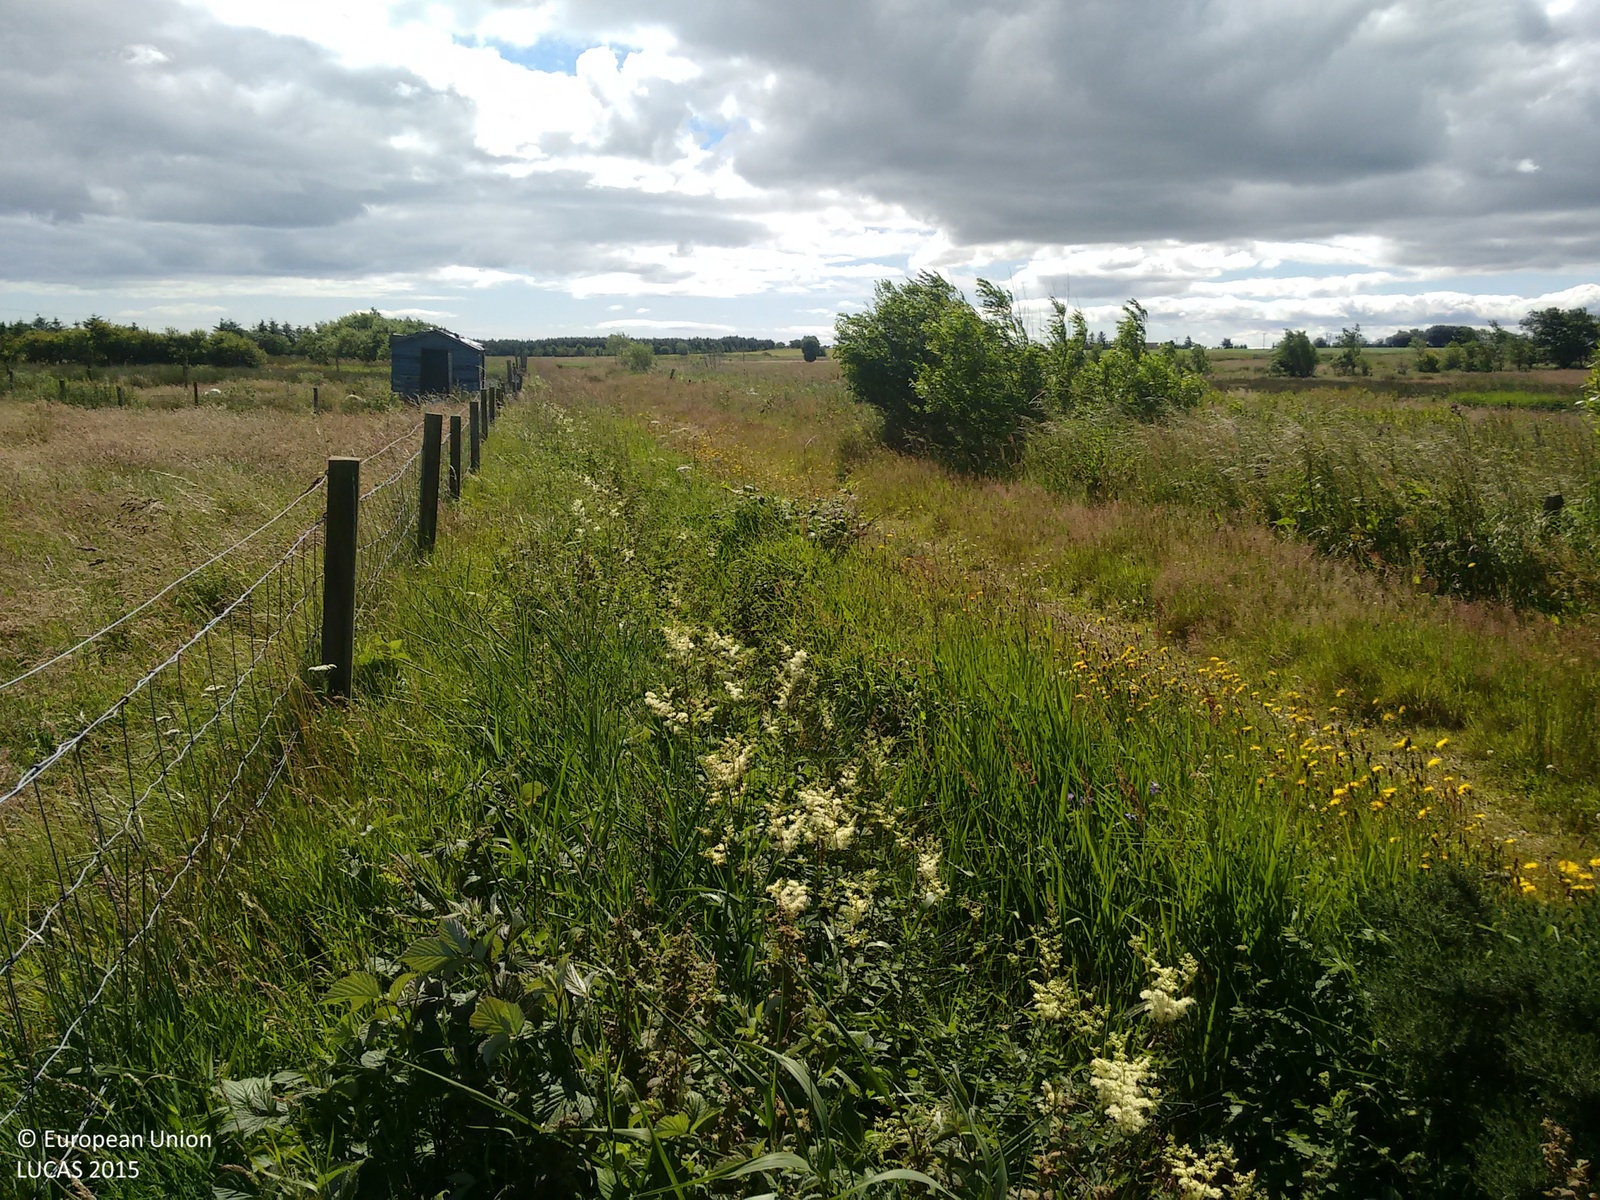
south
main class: Grassland
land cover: Grassland without tree/shrub cover
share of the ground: > 75 %
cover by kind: herbaceous plants 100 %
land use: Residential
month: July
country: GB
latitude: 57.5350
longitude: -1.9875
